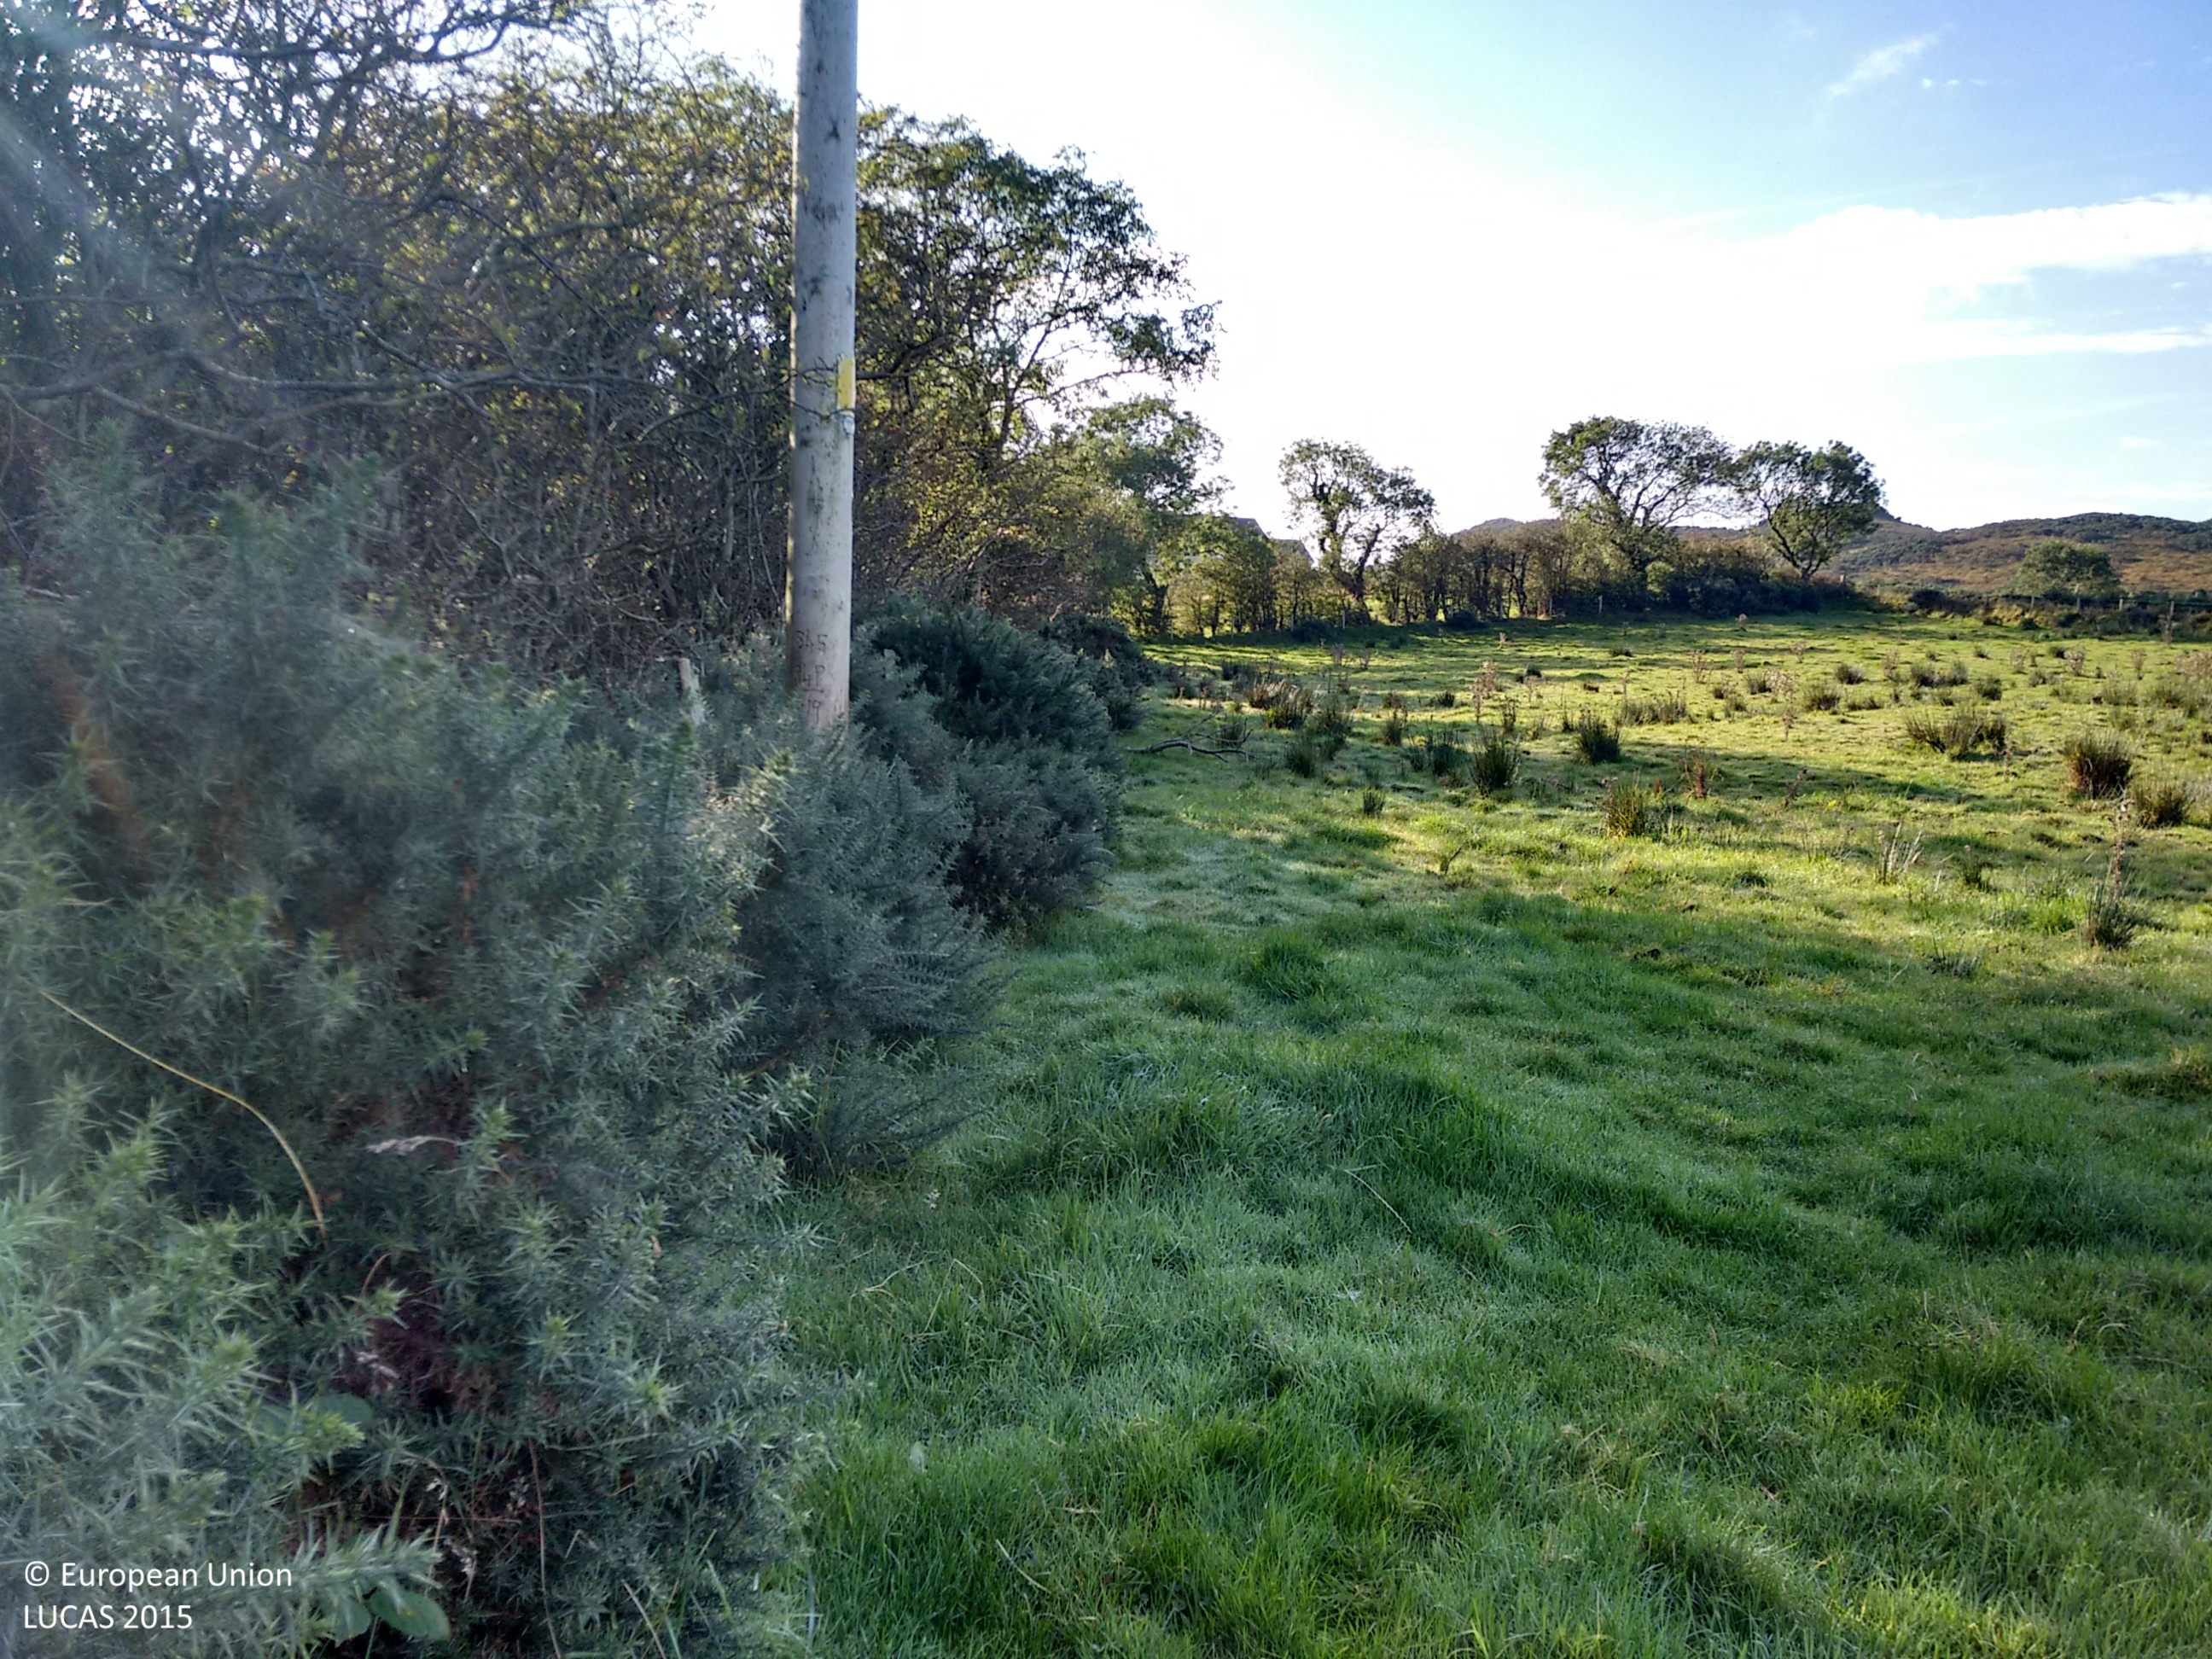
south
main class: Grassland
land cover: Grassland without tree/shrub cover
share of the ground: > 75 %
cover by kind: herbaceous plants 100 %
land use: Agriculture (excluding fallow land and kitchen gardens)
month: September
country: IE
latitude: 55.1728
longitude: -7.7627
